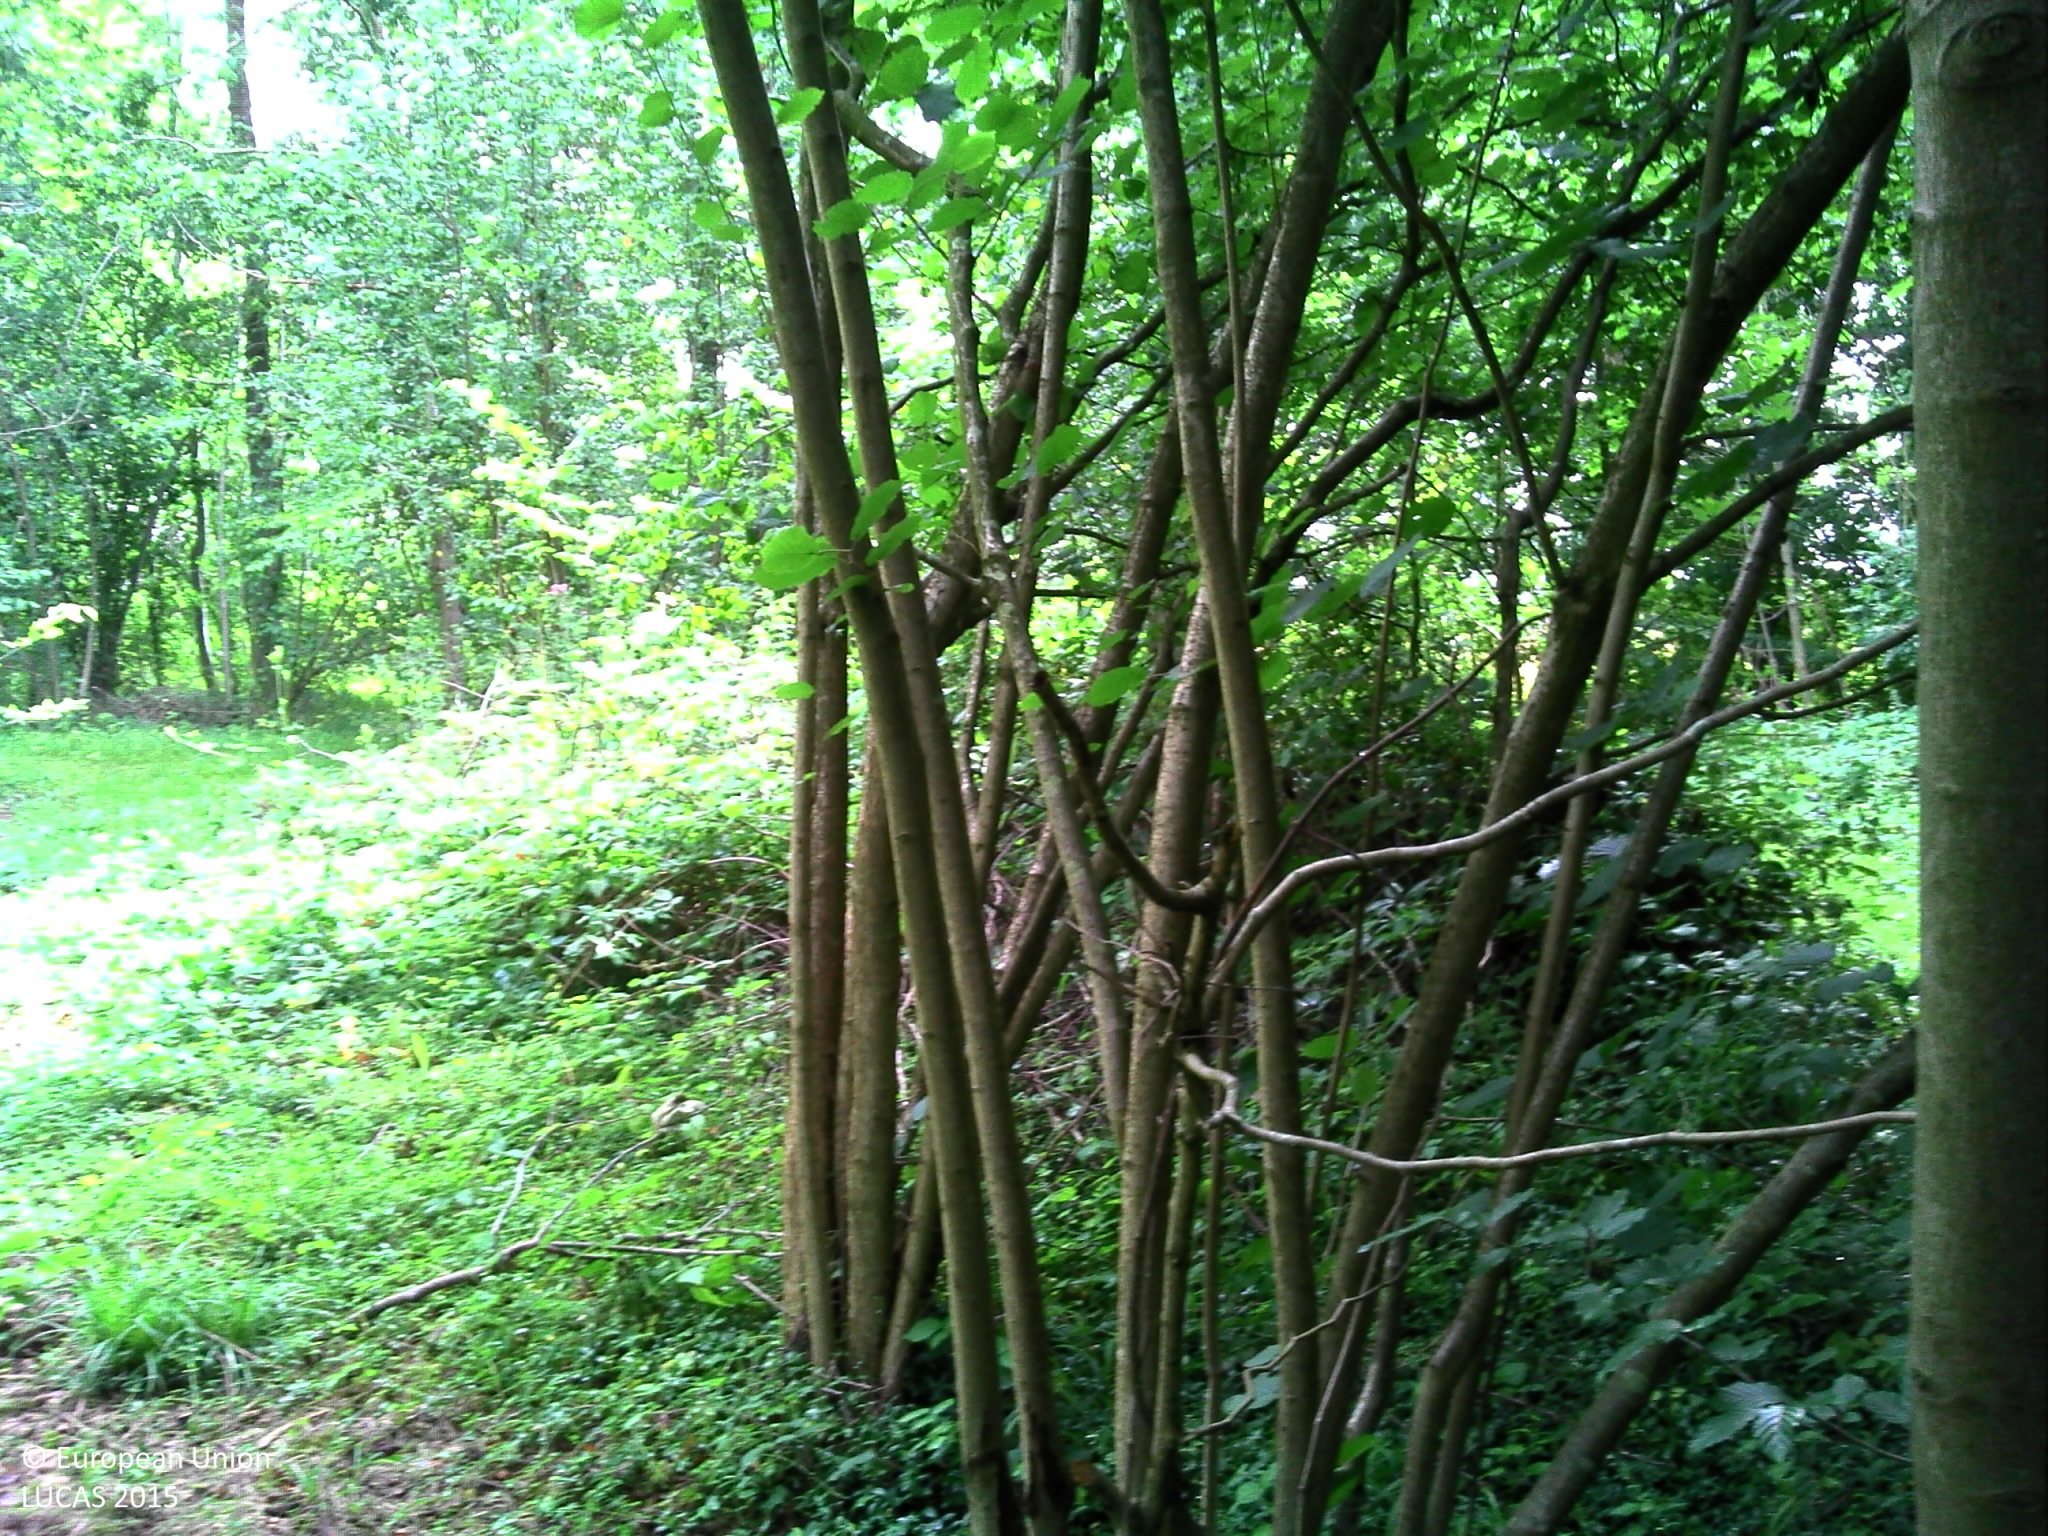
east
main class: Woodland
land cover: Broadleaved woodland
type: mesophytic deciduous forest
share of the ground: > 75 %
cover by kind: broadleaved forest trees 80 %, herbaceous plants 20 %
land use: Forestry
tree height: > 5 m
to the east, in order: Broadleaved woodland; Shruby margins; Grassland with sparse tree/shrub cover; Grassland without tree/shrub cover; Broadleaved woodland; Barley; Oats; Sugar beet; Barley
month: July
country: FR
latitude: 50.8278
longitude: 2.0483
